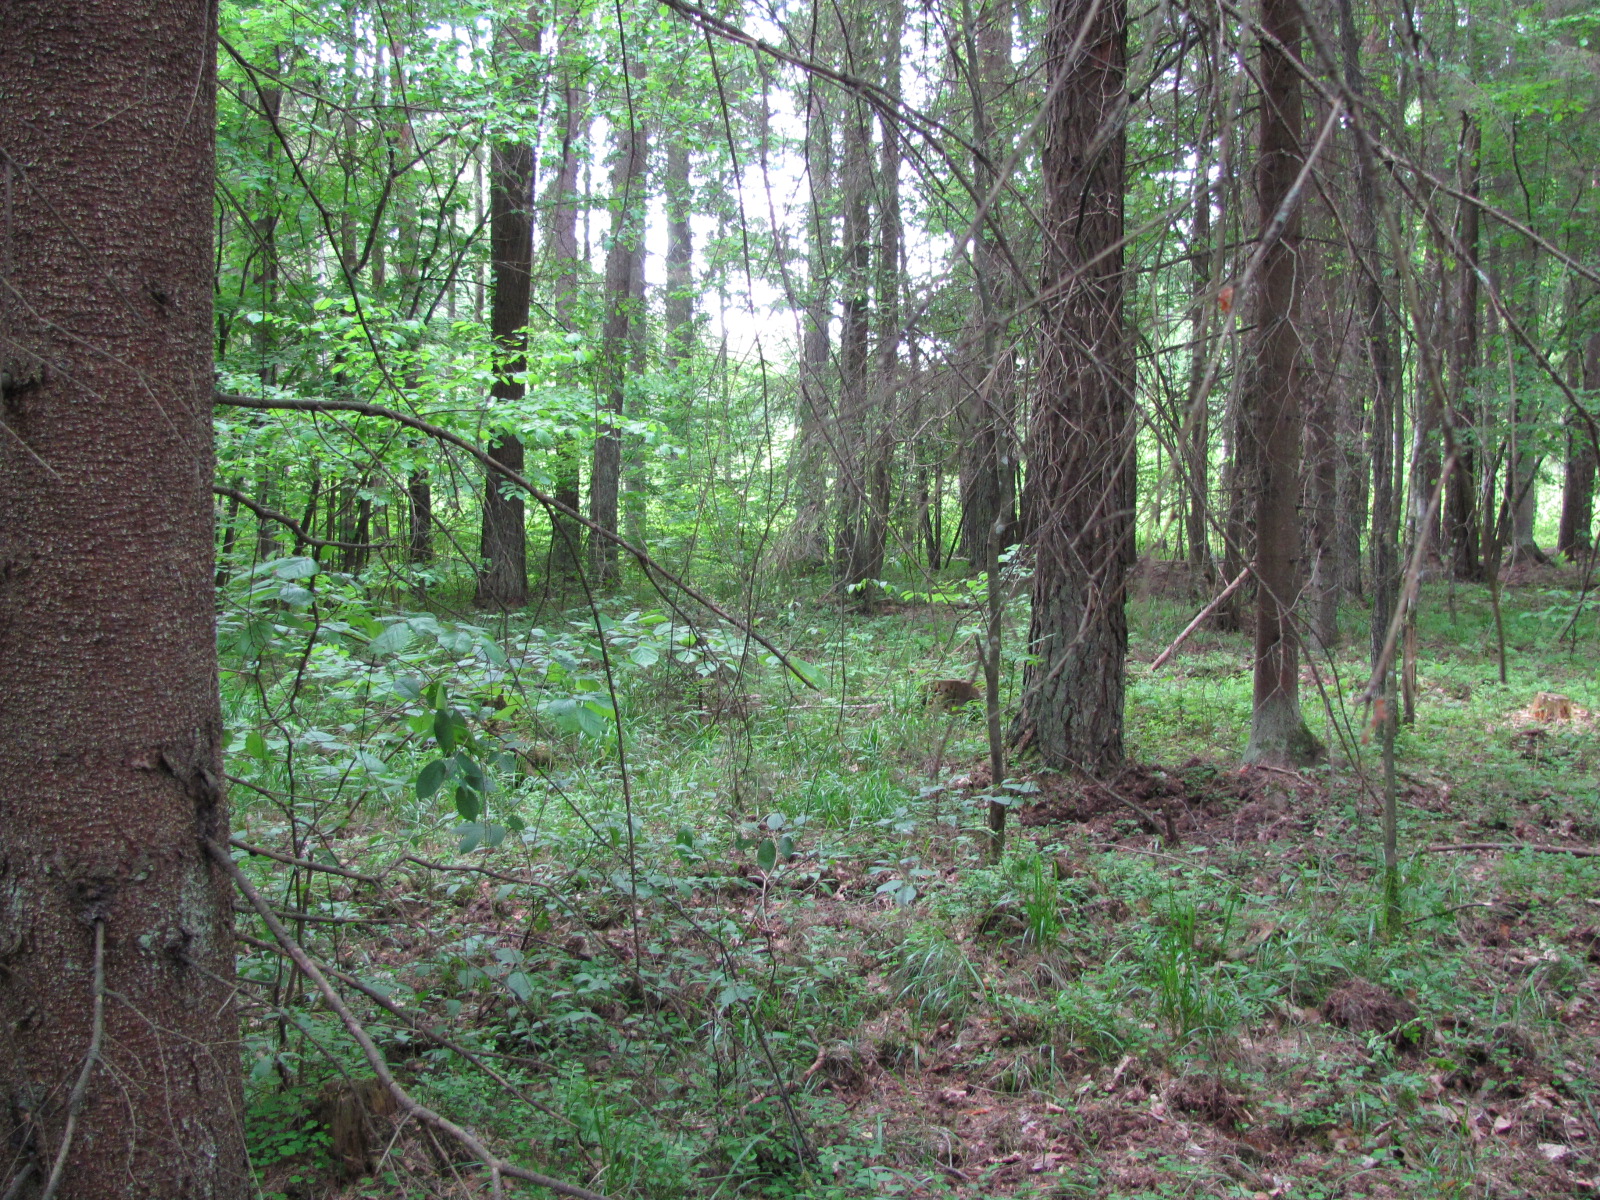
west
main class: Woodland
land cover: Other mixed woodland
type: hemiboreal forest and nemoral coniferous forest and mixed broadleaved-coniferous forest
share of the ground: > 75 %
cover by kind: coniferous forest trees 50 %, broadleaved forest trees 50 %
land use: Forestry
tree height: > 5 m
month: June
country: LV
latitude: 56.6054
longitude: 23.8138
